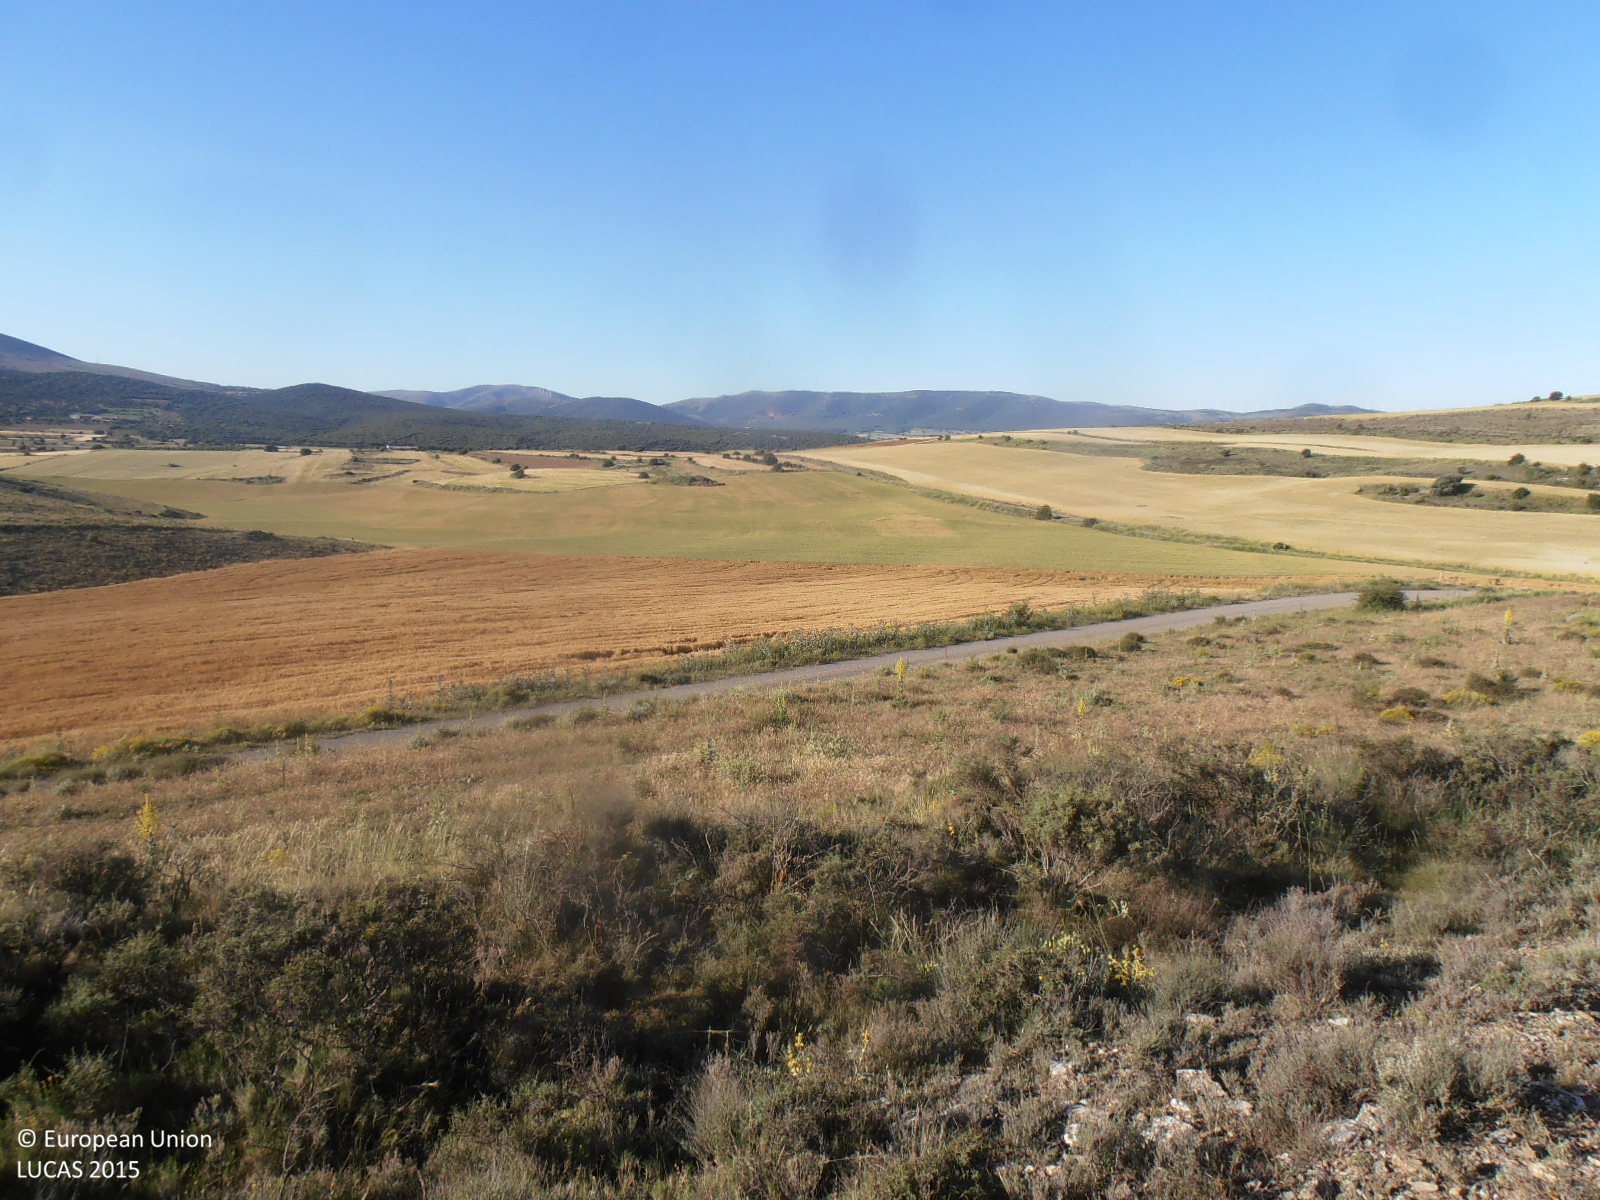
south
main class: Shrubland
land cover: Shrubland without tree cover
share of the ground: > 75 %
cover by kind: shrubs 80 %, herbaceous plants 10 %, consolidated bare surface 10 %
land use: Semi-natural and natural areas not in use
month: June
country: ES
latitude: 41.8325
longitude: -1.9661
